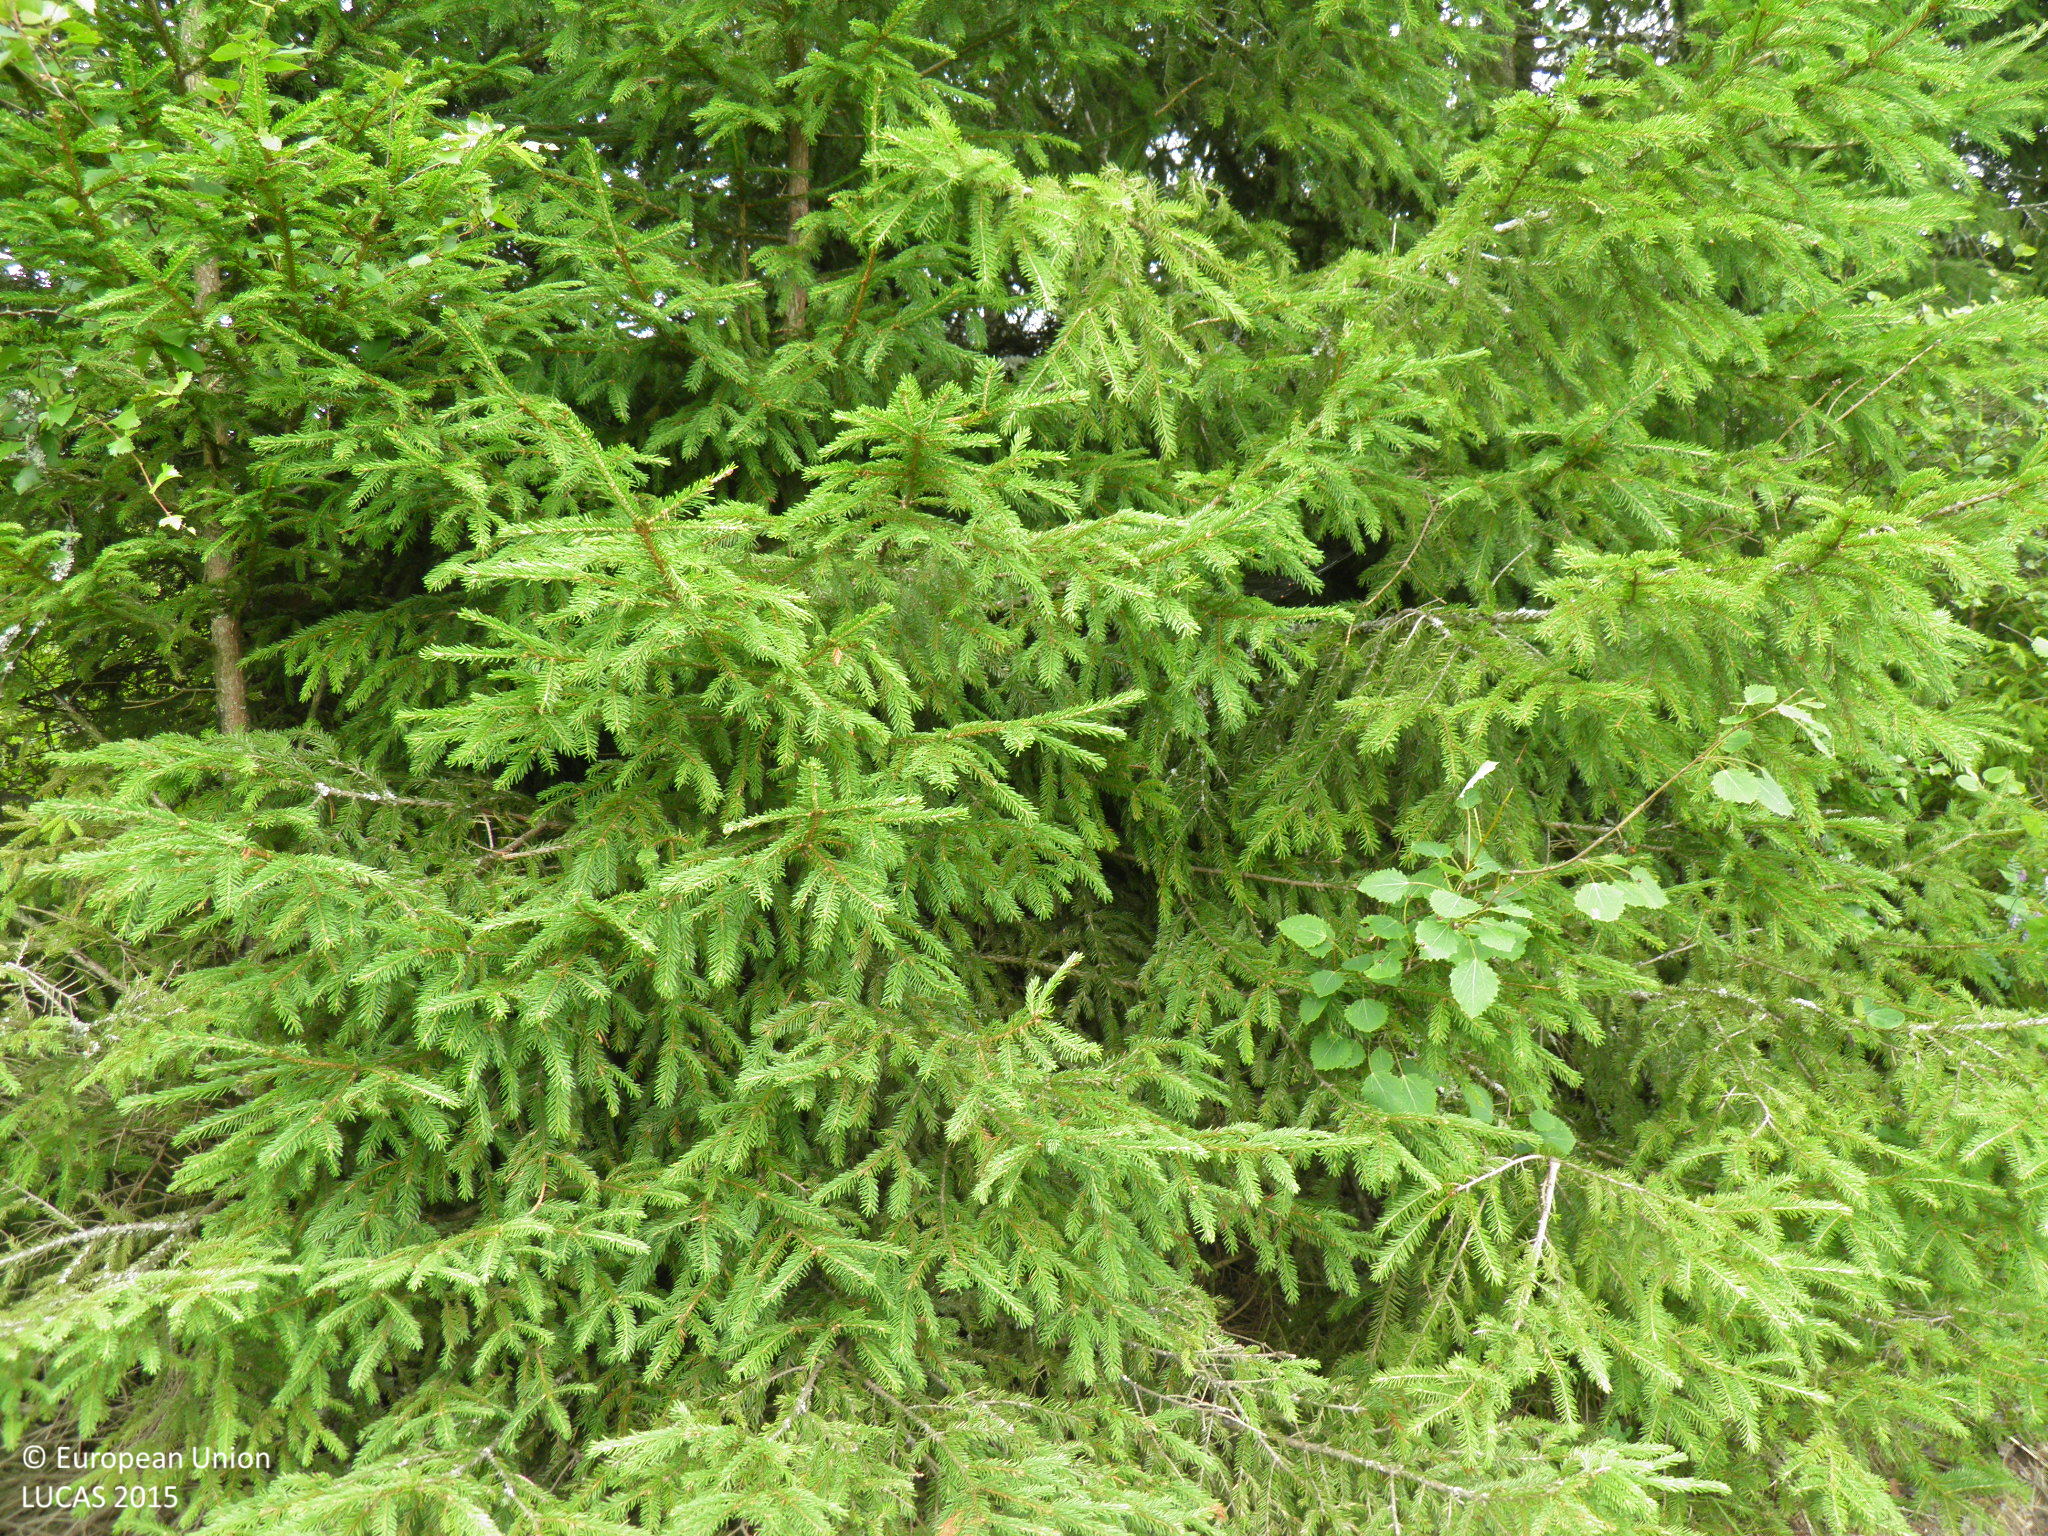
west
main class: Cropland
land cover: Common wheat
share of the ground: > 75 %
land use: Agriculture (excluding fallow land and kitchen gardens)
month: July
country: FI
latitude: 60.6571
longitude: 21.4894
